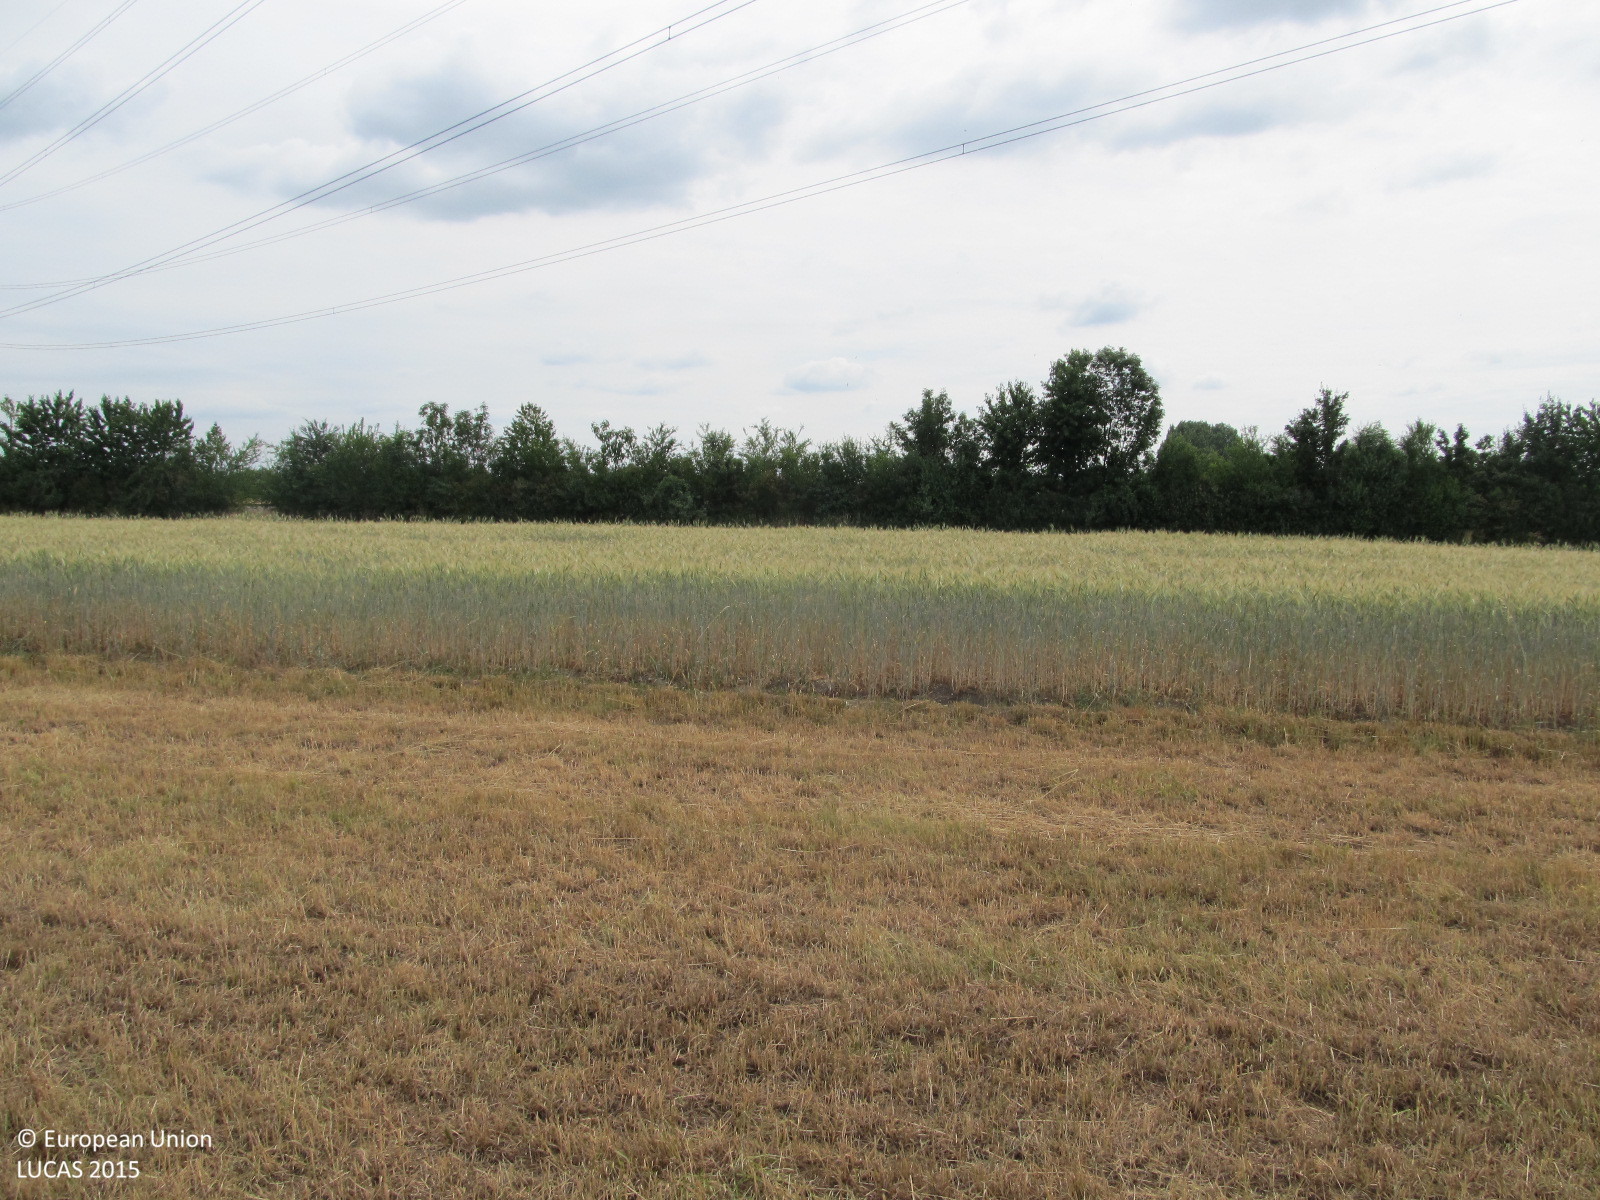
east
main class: Grassland
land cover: Grassland without tree/shrub cover
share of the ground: > 75 %
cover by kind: herbaceous plants 100 %
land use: Agriculture (excluding fallow land and kitchen gardens)
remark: Harvested field
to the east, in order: Grassland without tree/shrub cover; Electric lines; Barley; Groves; Grass margins; Railways; Grass margins; Barley; Triticale
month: June
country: AT
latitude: 48.3197
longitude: 15.8699
